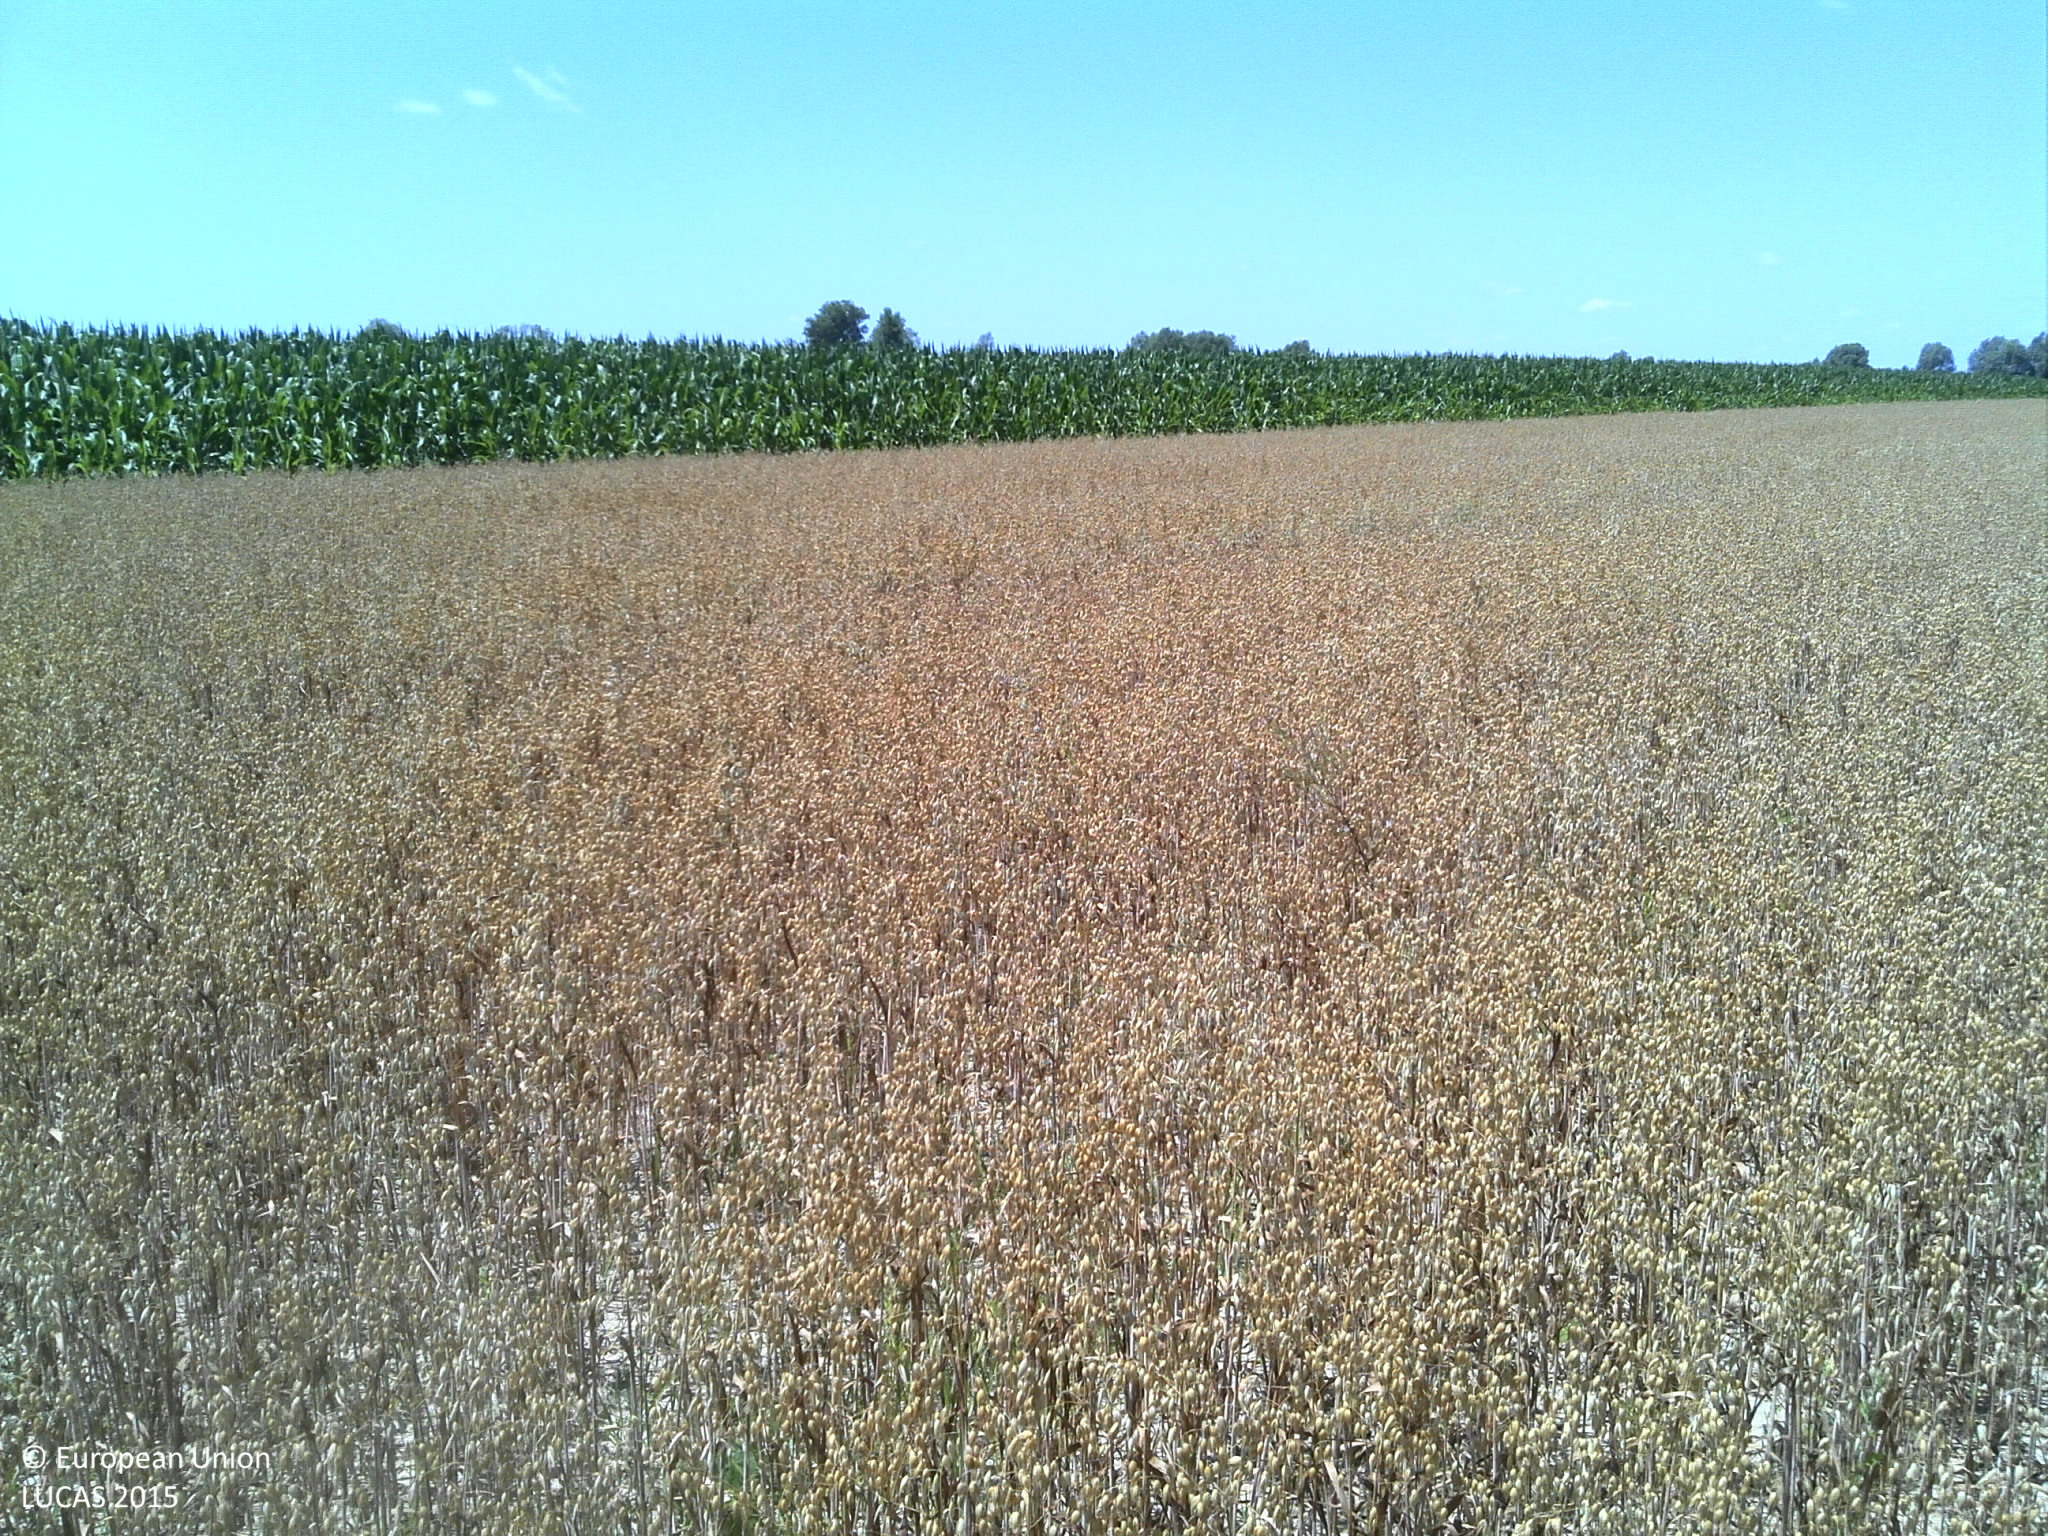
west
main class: Cropland
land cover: Oats
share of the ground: > 75 %
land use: Agriculture (excluding fallow land and kitchen gardens)
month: July
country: HR
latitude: 45.8023
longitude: 16.9098
